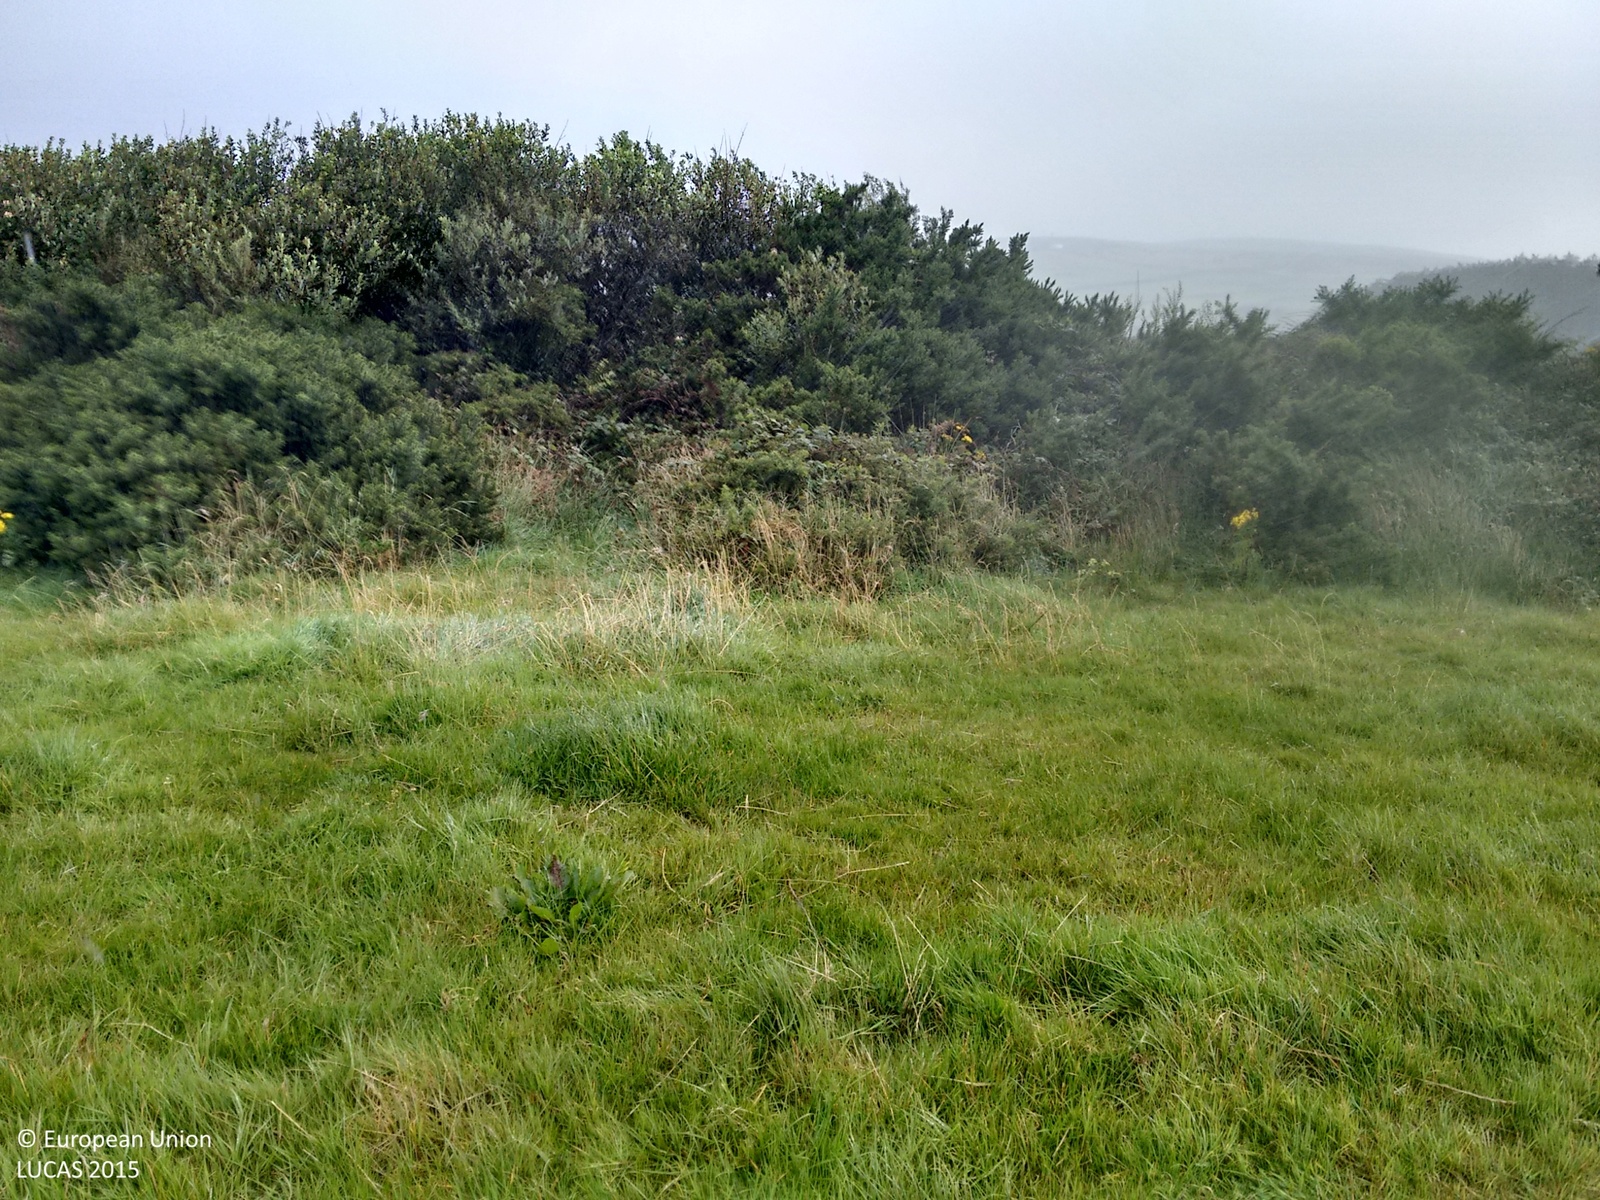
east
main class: Grassland
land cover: Grassland without tree/shrub cover
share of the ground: > 75 %
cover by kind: herbaceous plants 95 %, shrubs 5 %
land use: Agriculture (excluding fallow land and kitchen gardens)
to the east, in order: Grassland without tree/shrub cover; Abandoned hedges; Grassland without tree/shrub cover; Abandoned hedges; Grassland without tree/shrub cover; Abandoned hedges; Grassland without tree/shrub cover; Abandoned hedges; Grassland with sparse tree/shrub cover; Artificial constructions in urban areas
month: August
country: IE
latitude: 51.9065
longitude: -10.3425
